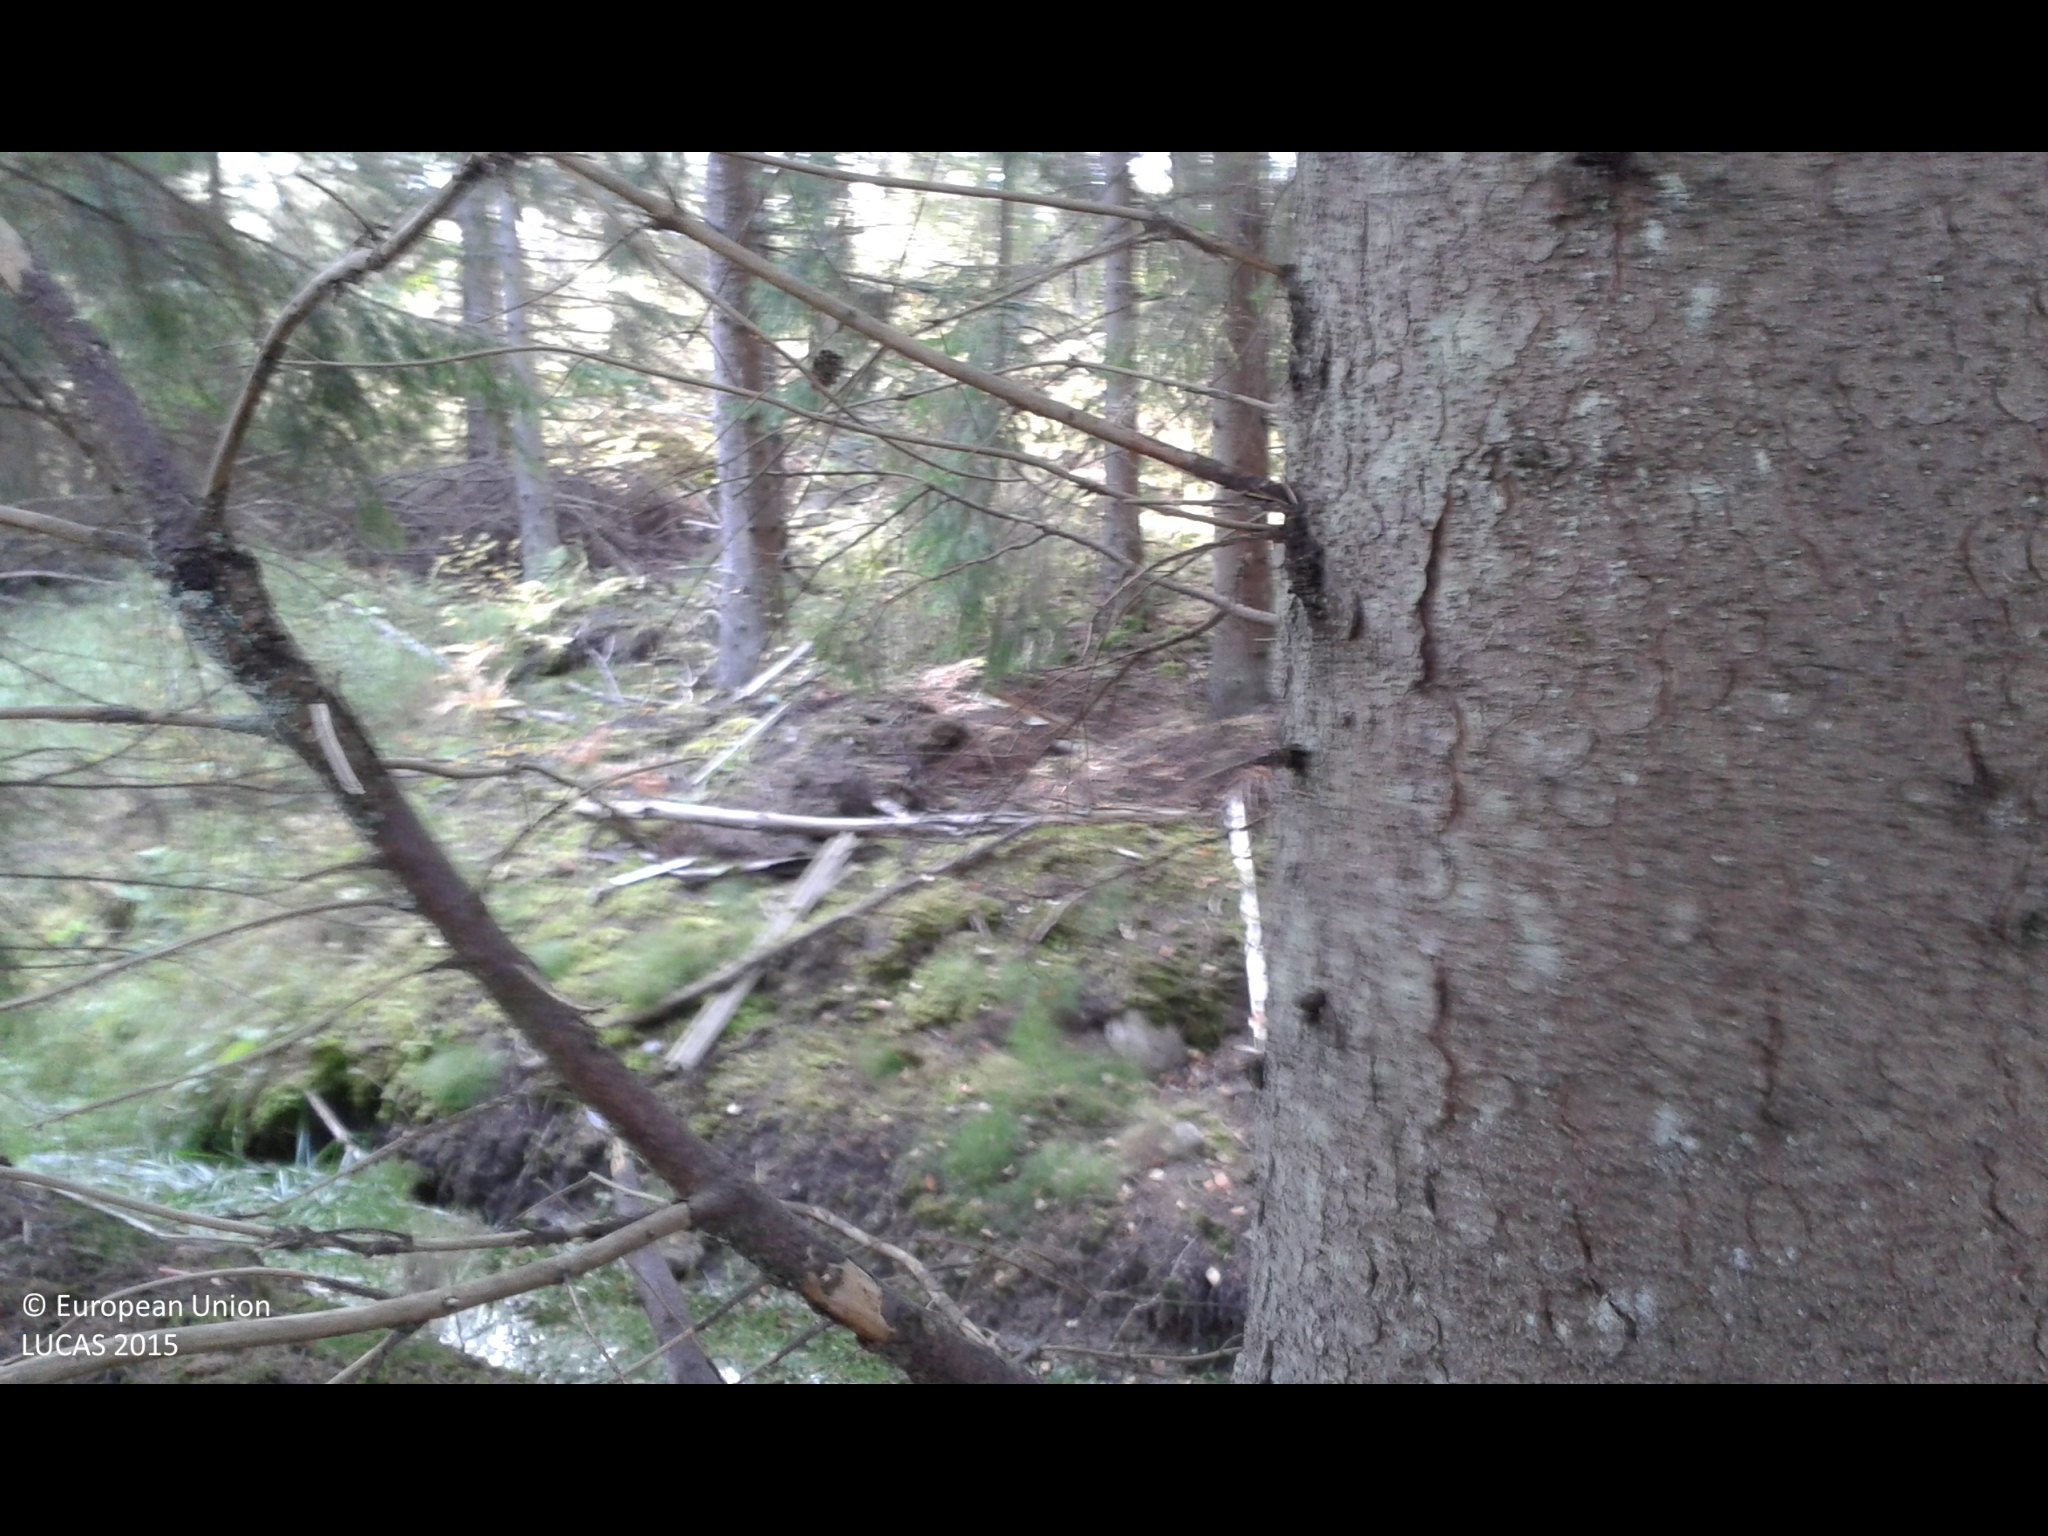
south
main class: Woodland
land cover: Spruce dominated coniferous woodland
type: boreal forest
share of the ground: > 75 %
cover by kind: coniferous forest trees 80 %, herbaceous plants 20 %
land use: Forestry
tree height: > 5 m
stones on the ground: < 10 %
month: October
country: SE
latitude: 58.9704
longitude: 17.4589
